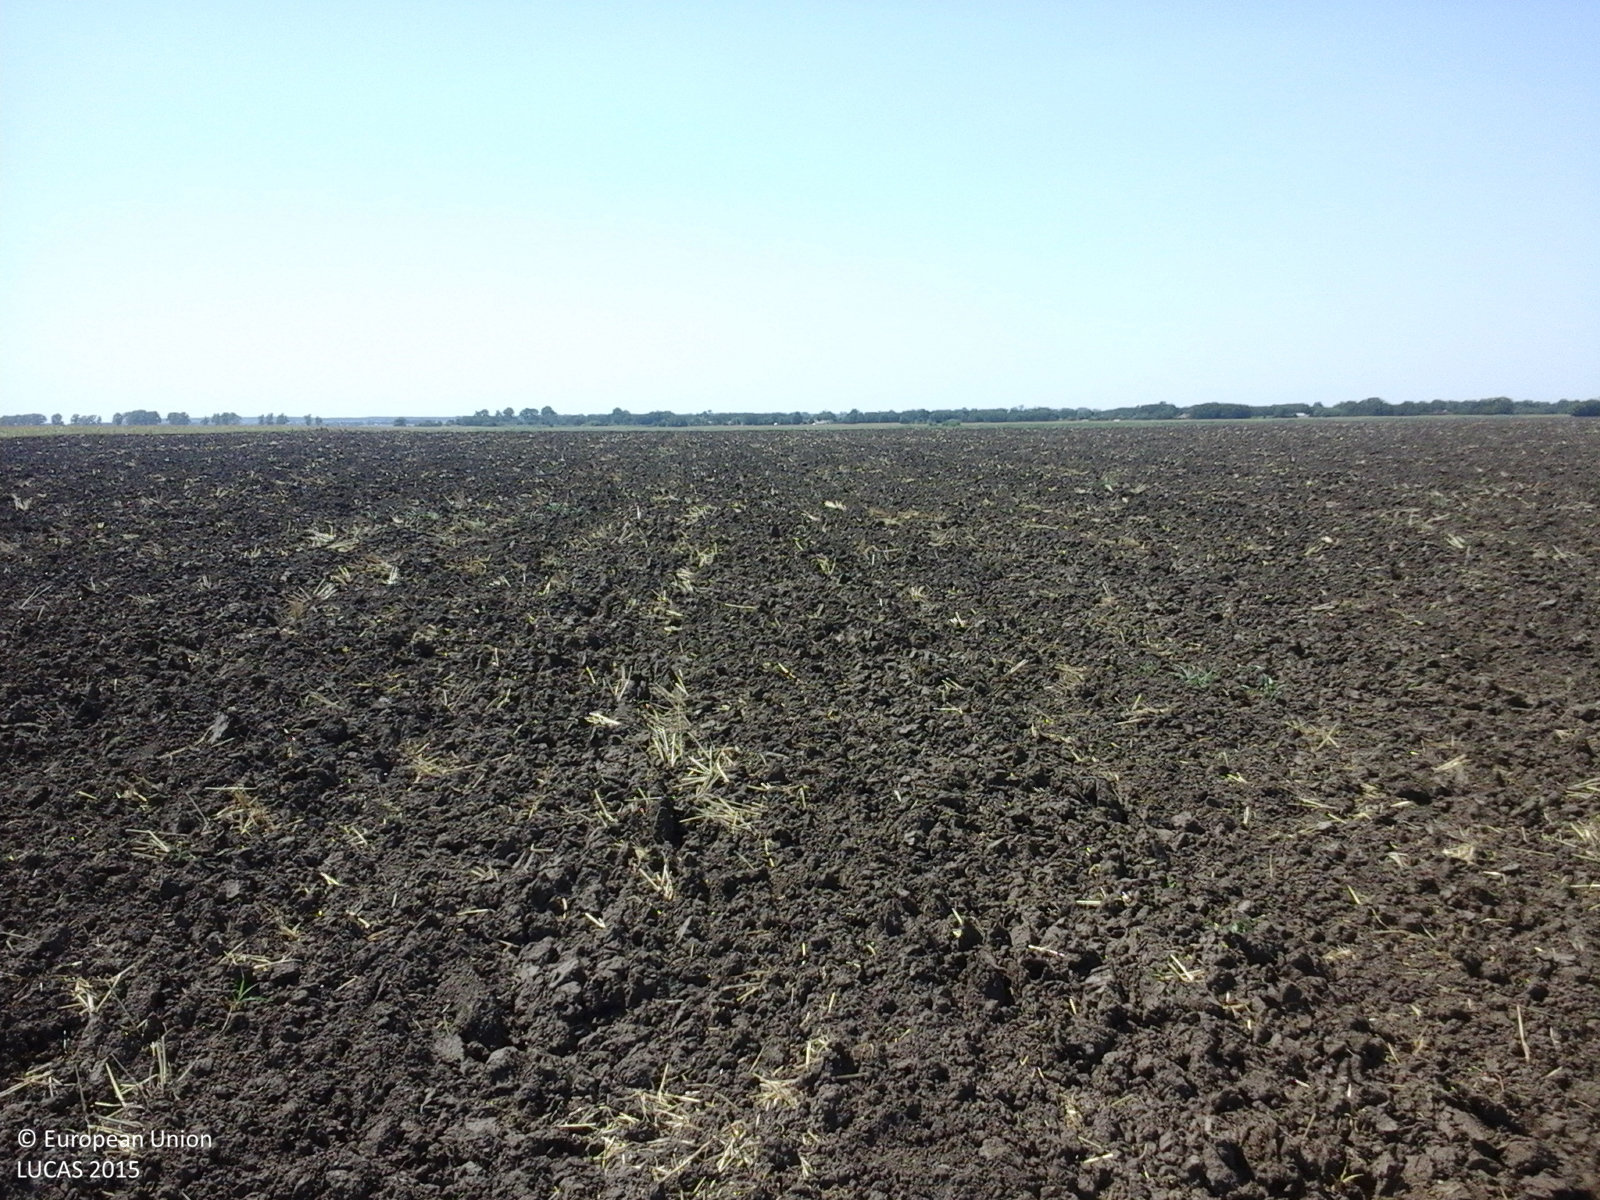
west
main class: Cropland
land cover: Common wheat
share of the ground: < 10 %
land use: Agriculture (excluding fallow land and kitchen gardens)
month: July
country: RO
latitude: 44.2467
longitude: 26.6341
